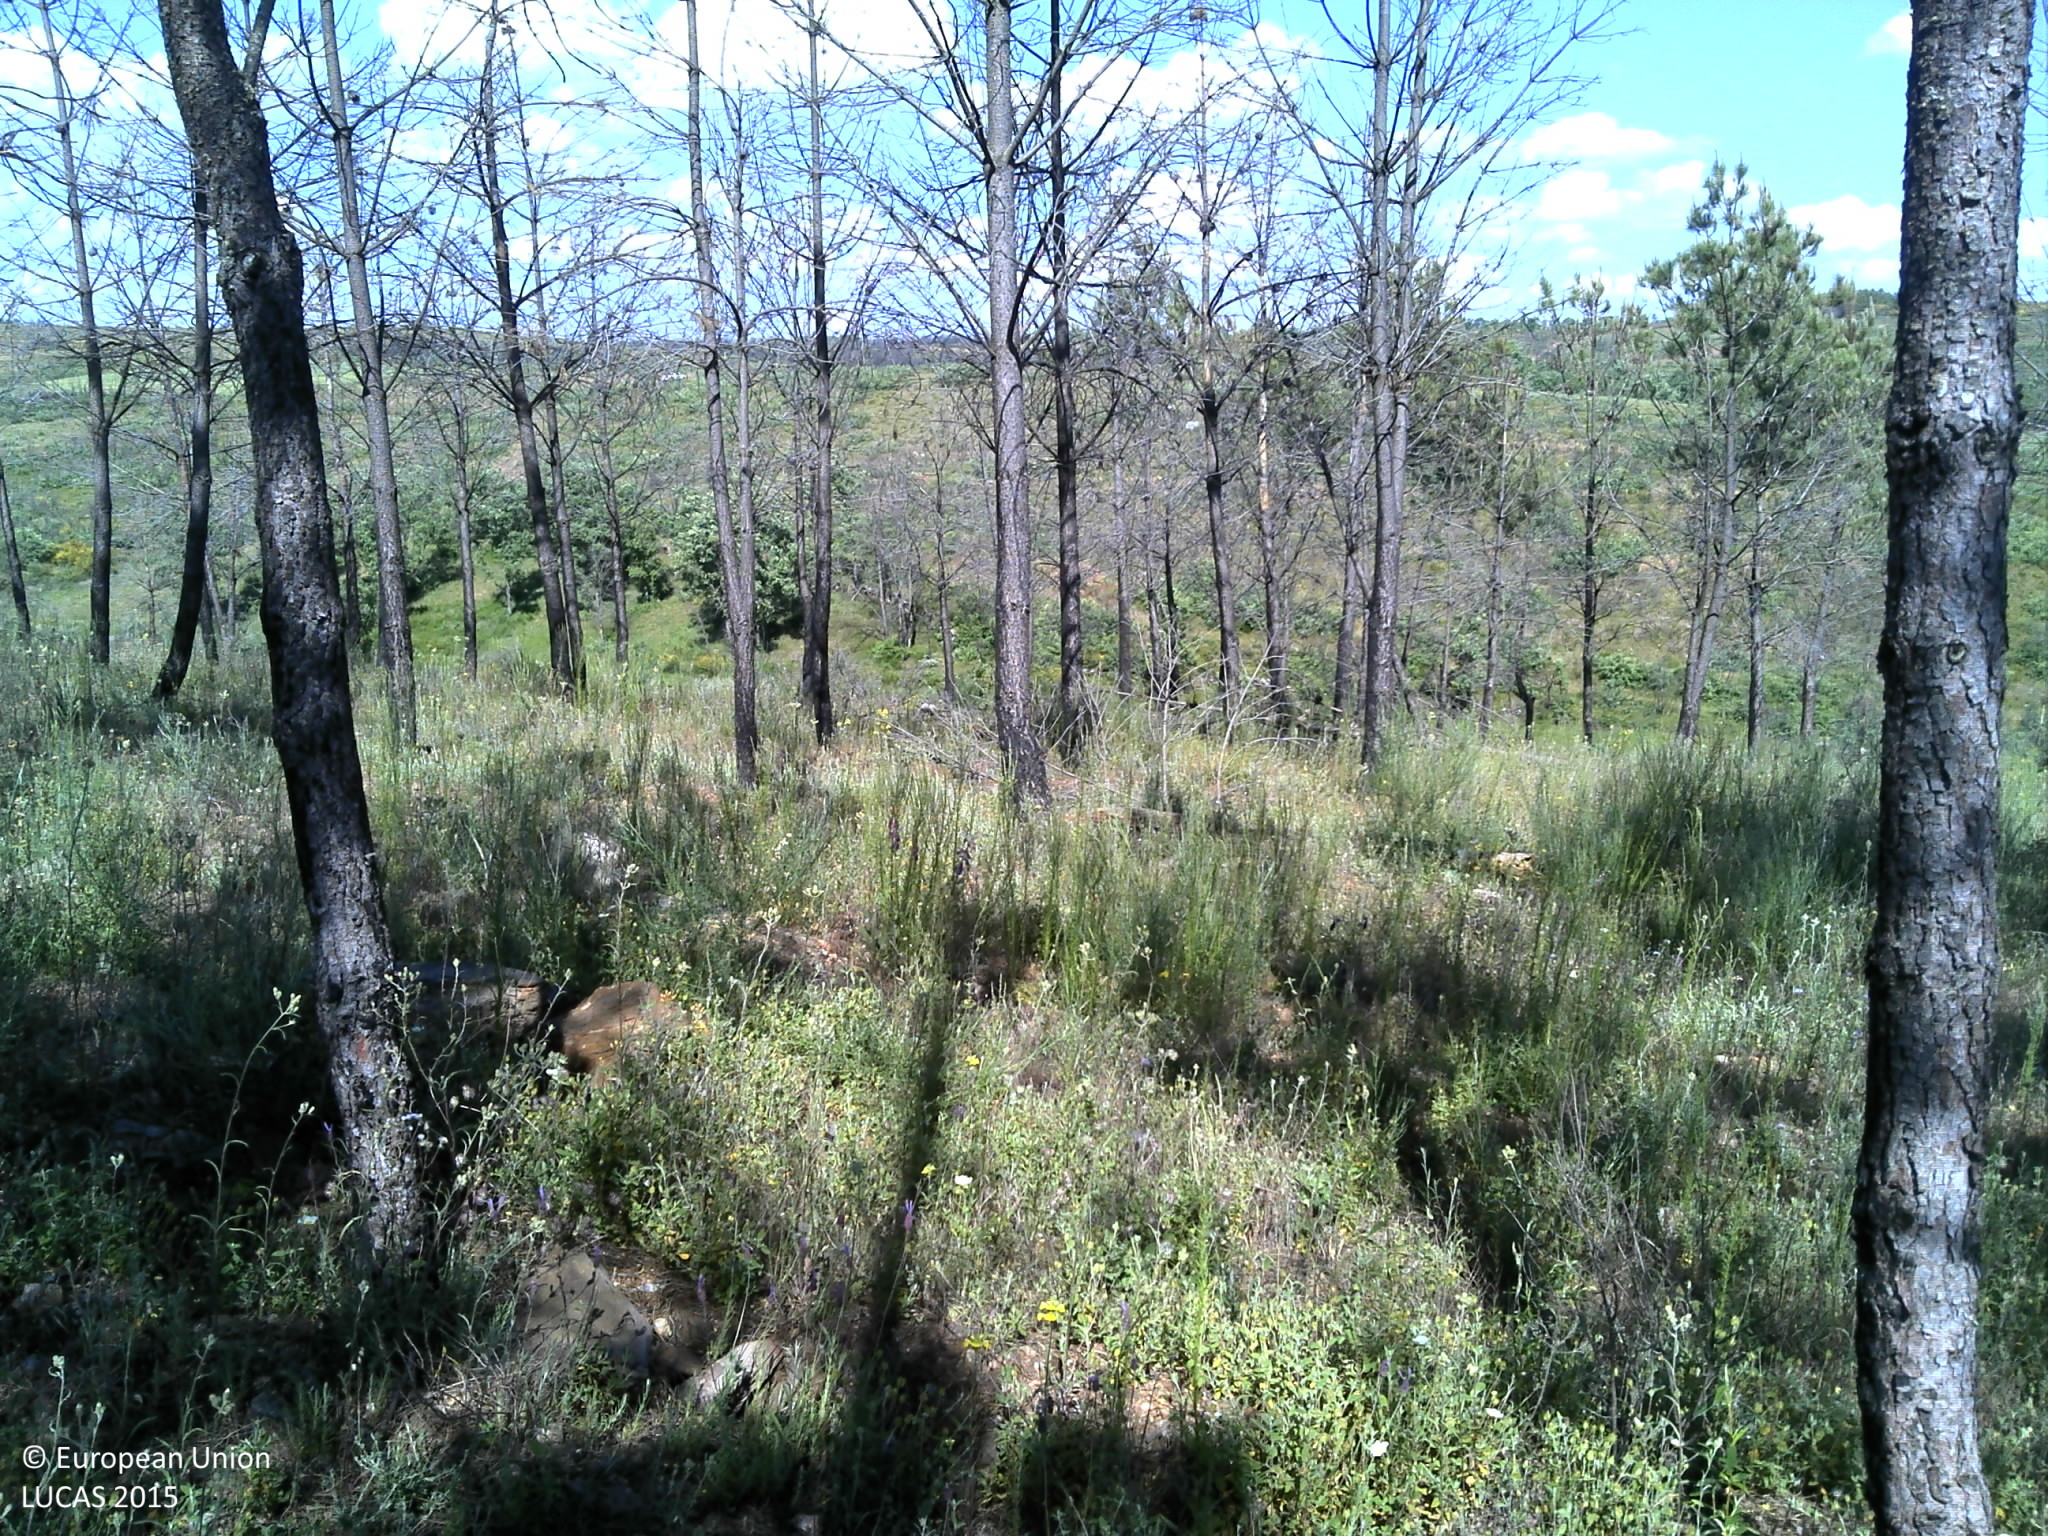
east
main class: Woodland
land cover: Pine dominated coniferous woodland
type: coniferous forest of the mediterranean region
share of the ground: 10 - 25 %
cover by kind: shrubs 50 %, unconsolidated bare surface 30 %, coniferous forest trees 20 %
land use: Forestry
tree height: > 5 m
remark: Burnt area
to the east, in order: Pine dominated coniferous woodland; Shrubland with sparse tree cover; Dry stone walls; Grassland without tree/shrub cover; Abandoned hedges; Dry stone walls; Shrubland with sparse tree cover; Tracks; Shrubland with sparse tree cover; Oats
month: May
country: PT
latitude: 41.6505
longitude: -6.3227
